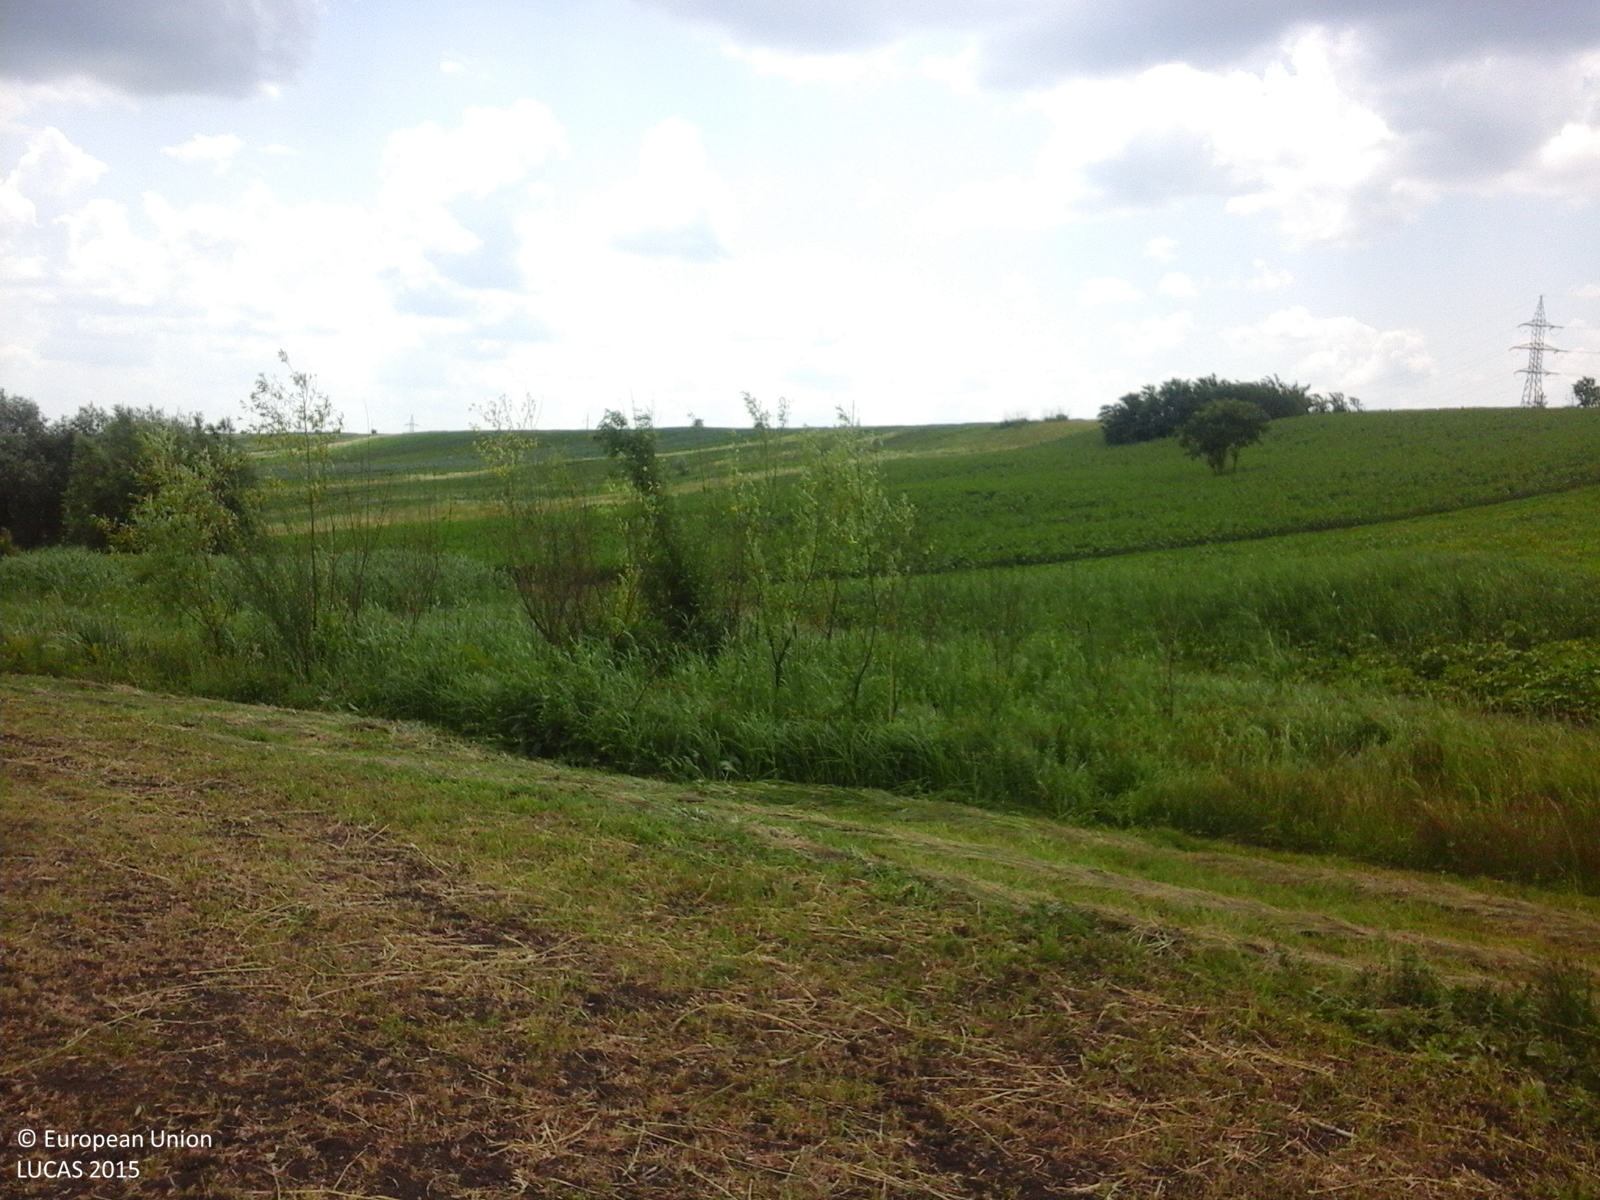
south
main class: Cropland
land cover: Oats
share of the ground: < 10 %
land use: Agriculture (excluding fallow land and kitchen gardens)
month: June
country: RO
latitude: 48.1410
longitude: 26.6404
